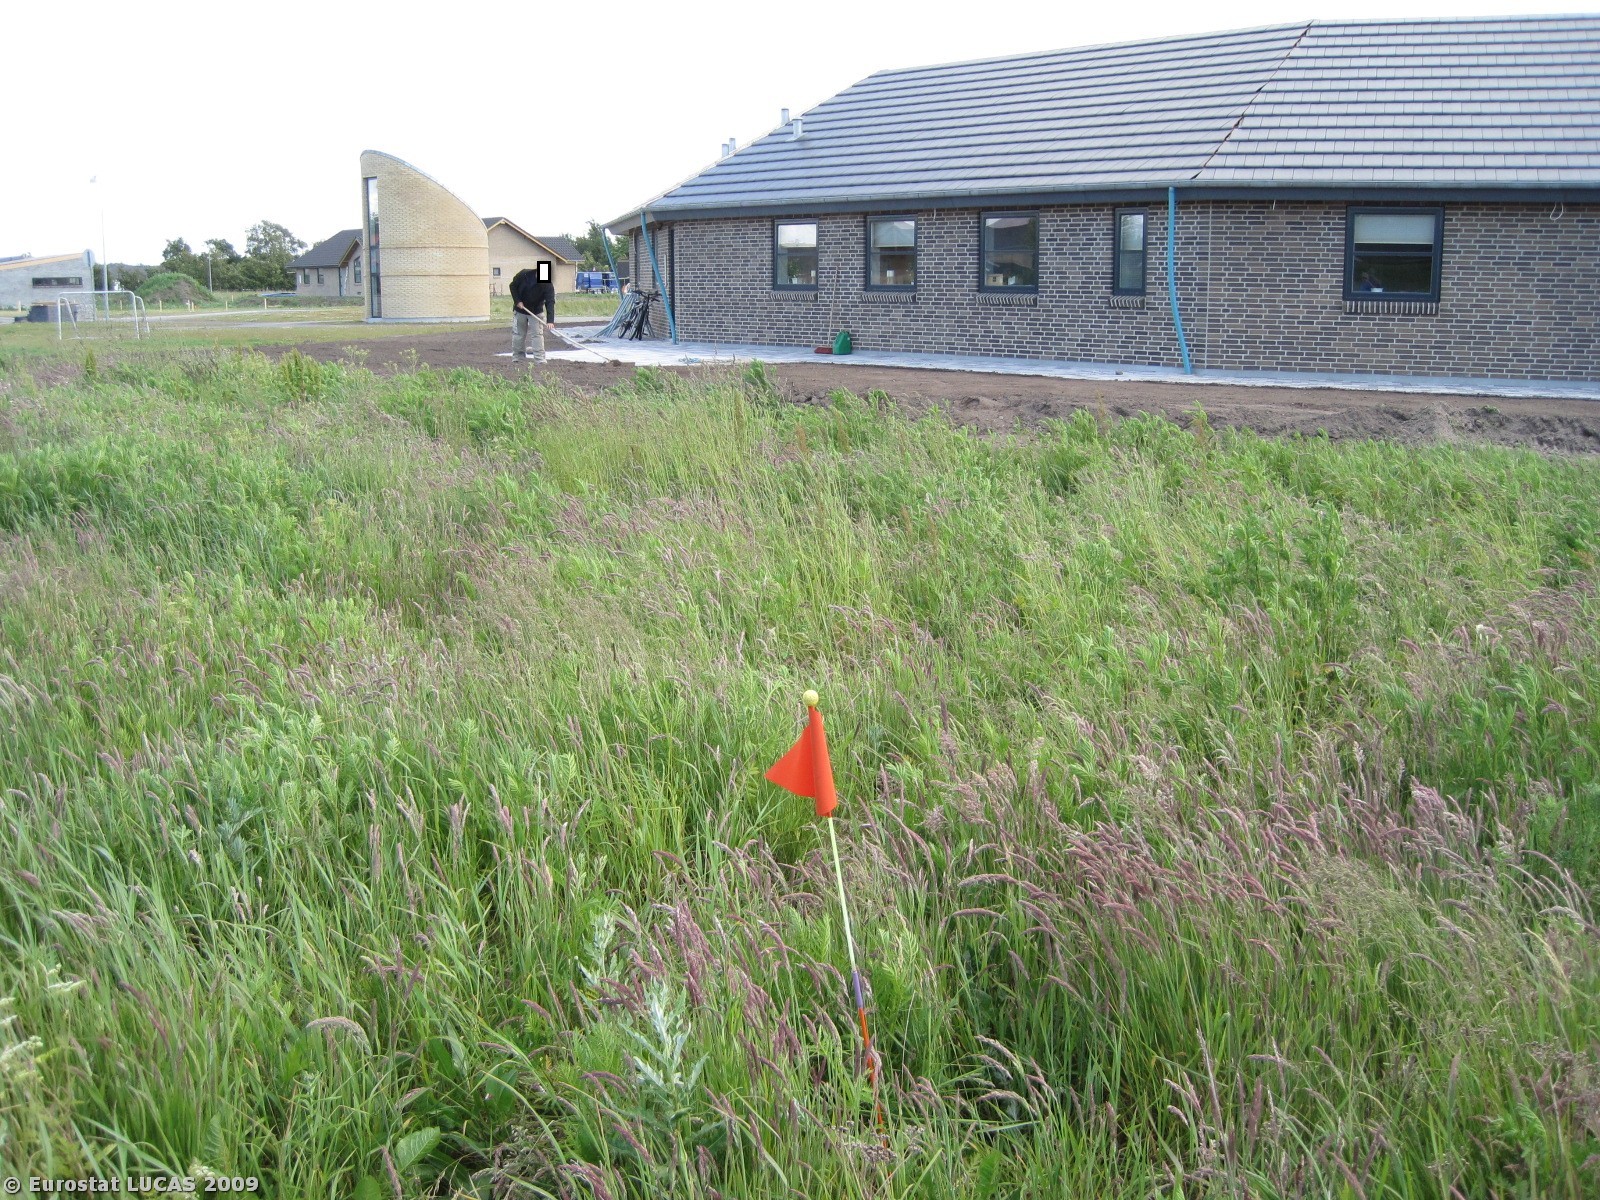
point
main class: Grassland
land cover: Grassland without tree/shrub cover
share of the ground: > 75 %
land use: Unused
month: June
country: DK
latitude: 57.1583
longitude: 9.7524
